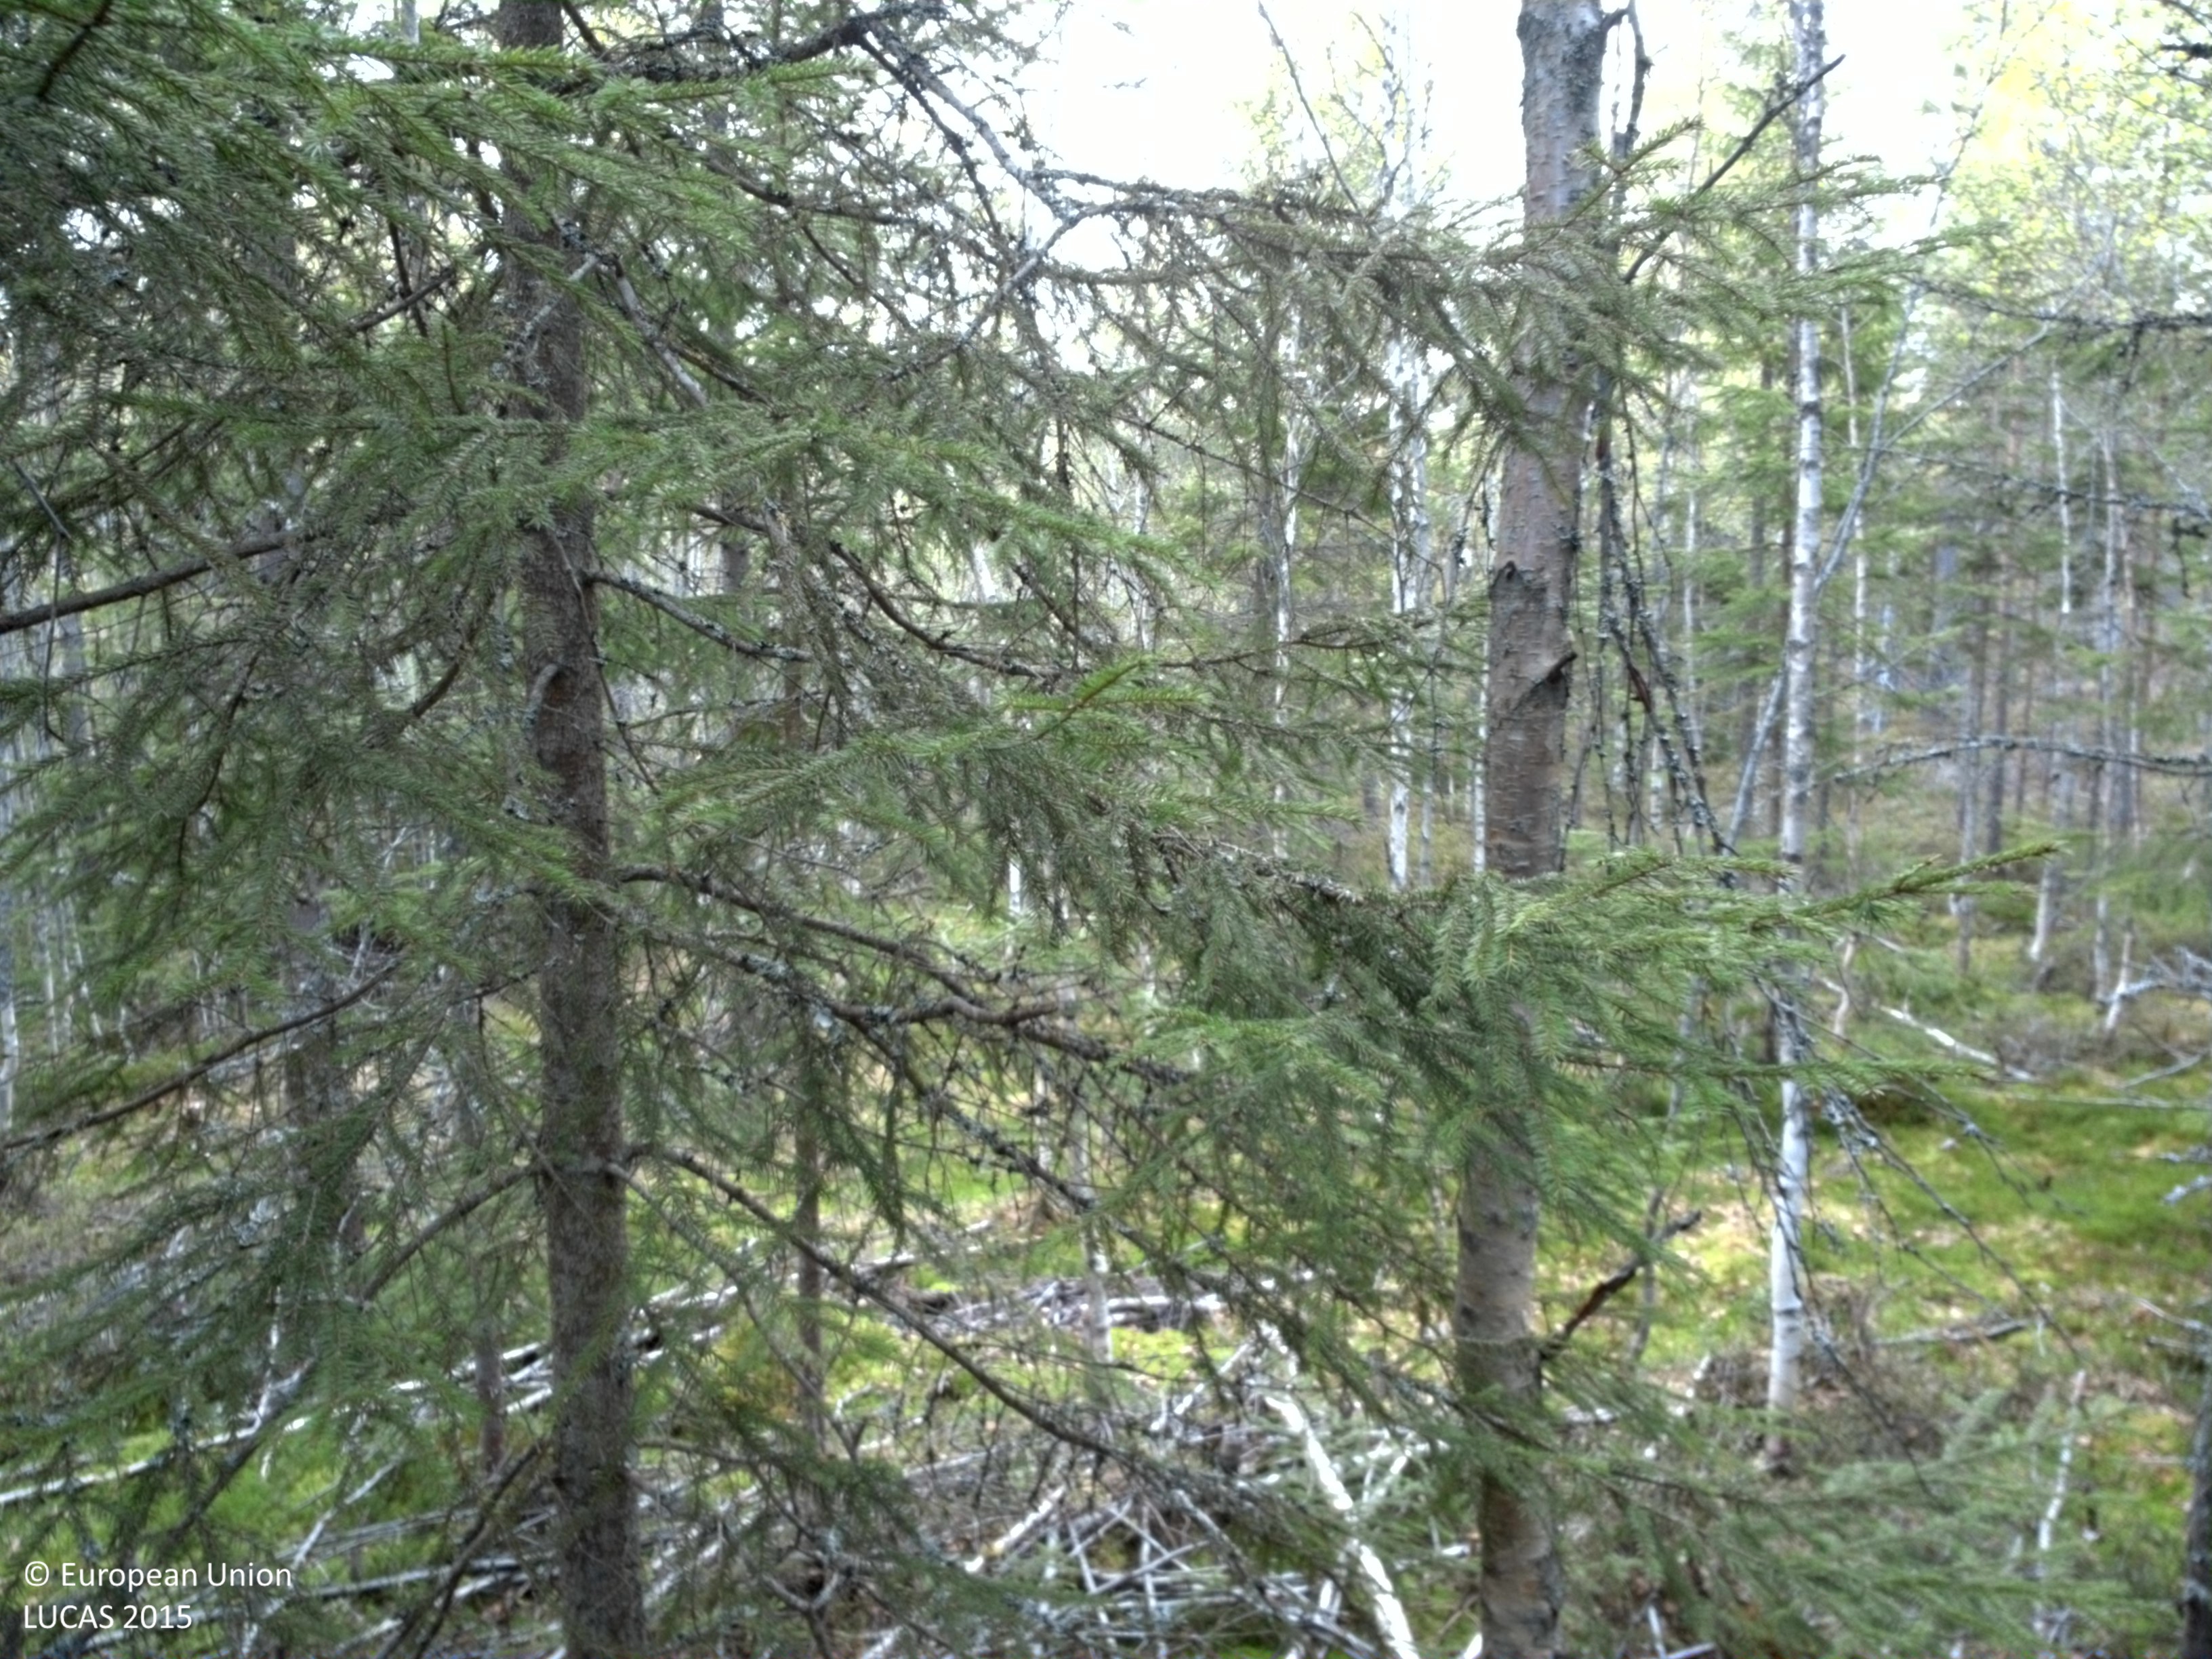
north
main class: Woodland
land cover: Other mixed woodland
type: boreal forest
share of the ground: > 75 %
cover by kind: coniferous forest trees 55 %, broadleaved forest trees 30 %, shrubs 15 %
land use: Forestry
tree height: > 5 m
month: May
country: SE
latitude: 60.3735
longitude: 13.4177
